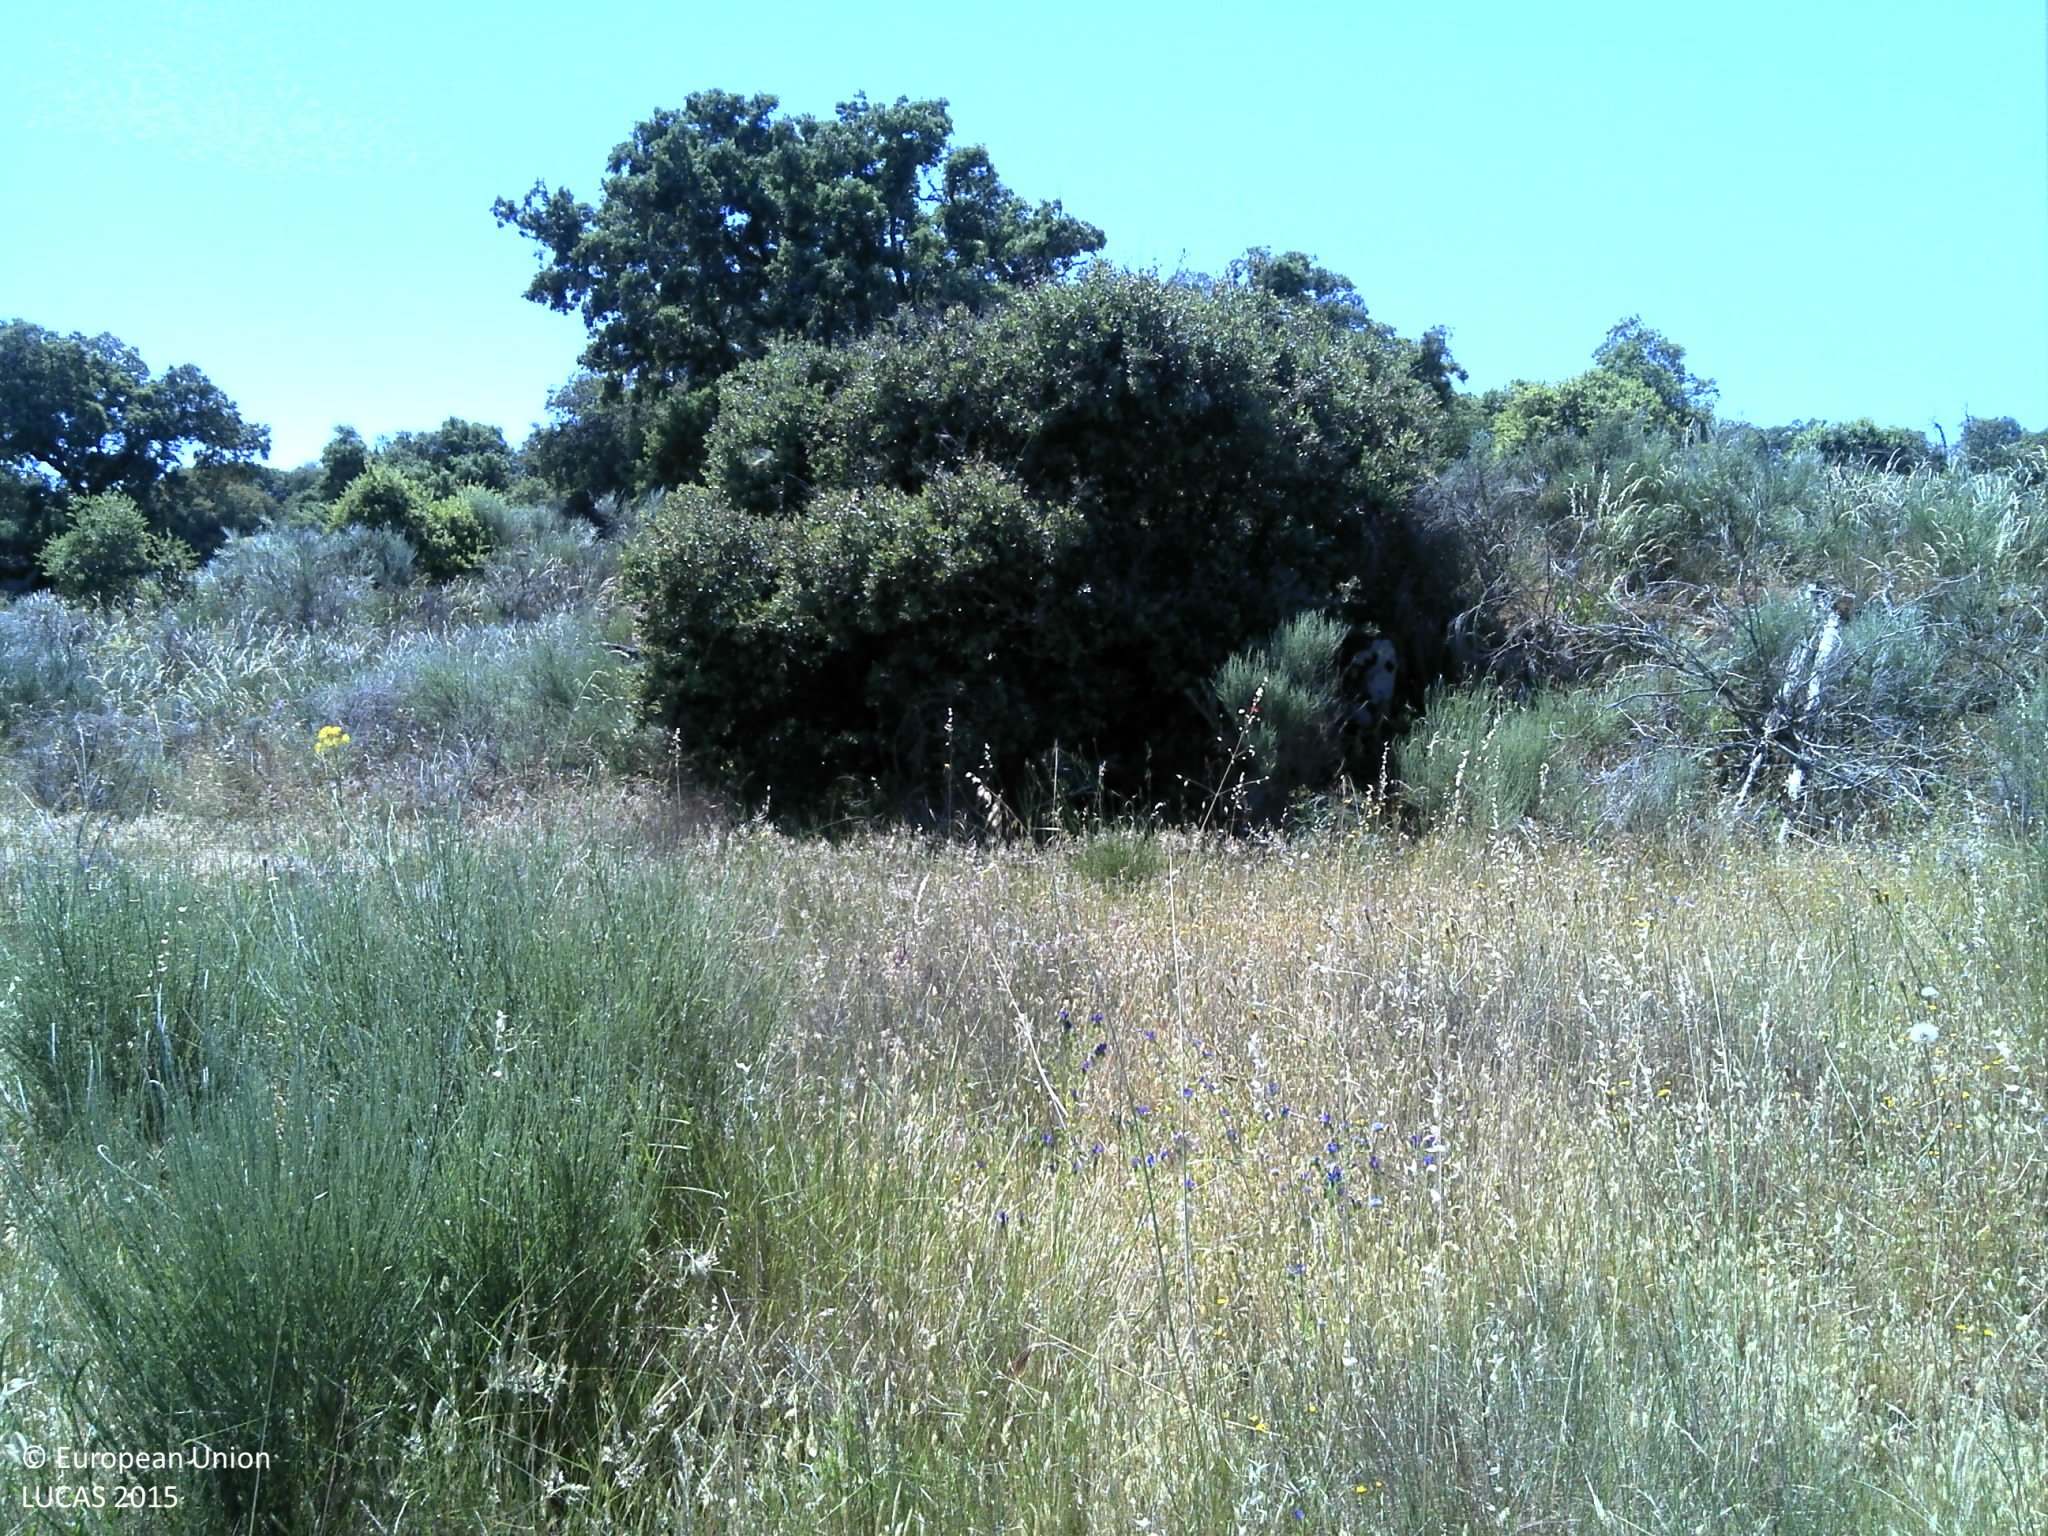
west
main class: Grassland
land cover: Grassland with sparse tree/shrub cover
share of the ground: > 75 %
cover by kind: herbaceous plants 80 %, unconsolidated bare surface 15 %, broadleaved forest trees 5 %
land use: Agriculture (excluding fallow land and kitchen gardens)
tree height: > 5 m
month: May
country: PT
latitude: 41.4276
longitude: -6.3360
